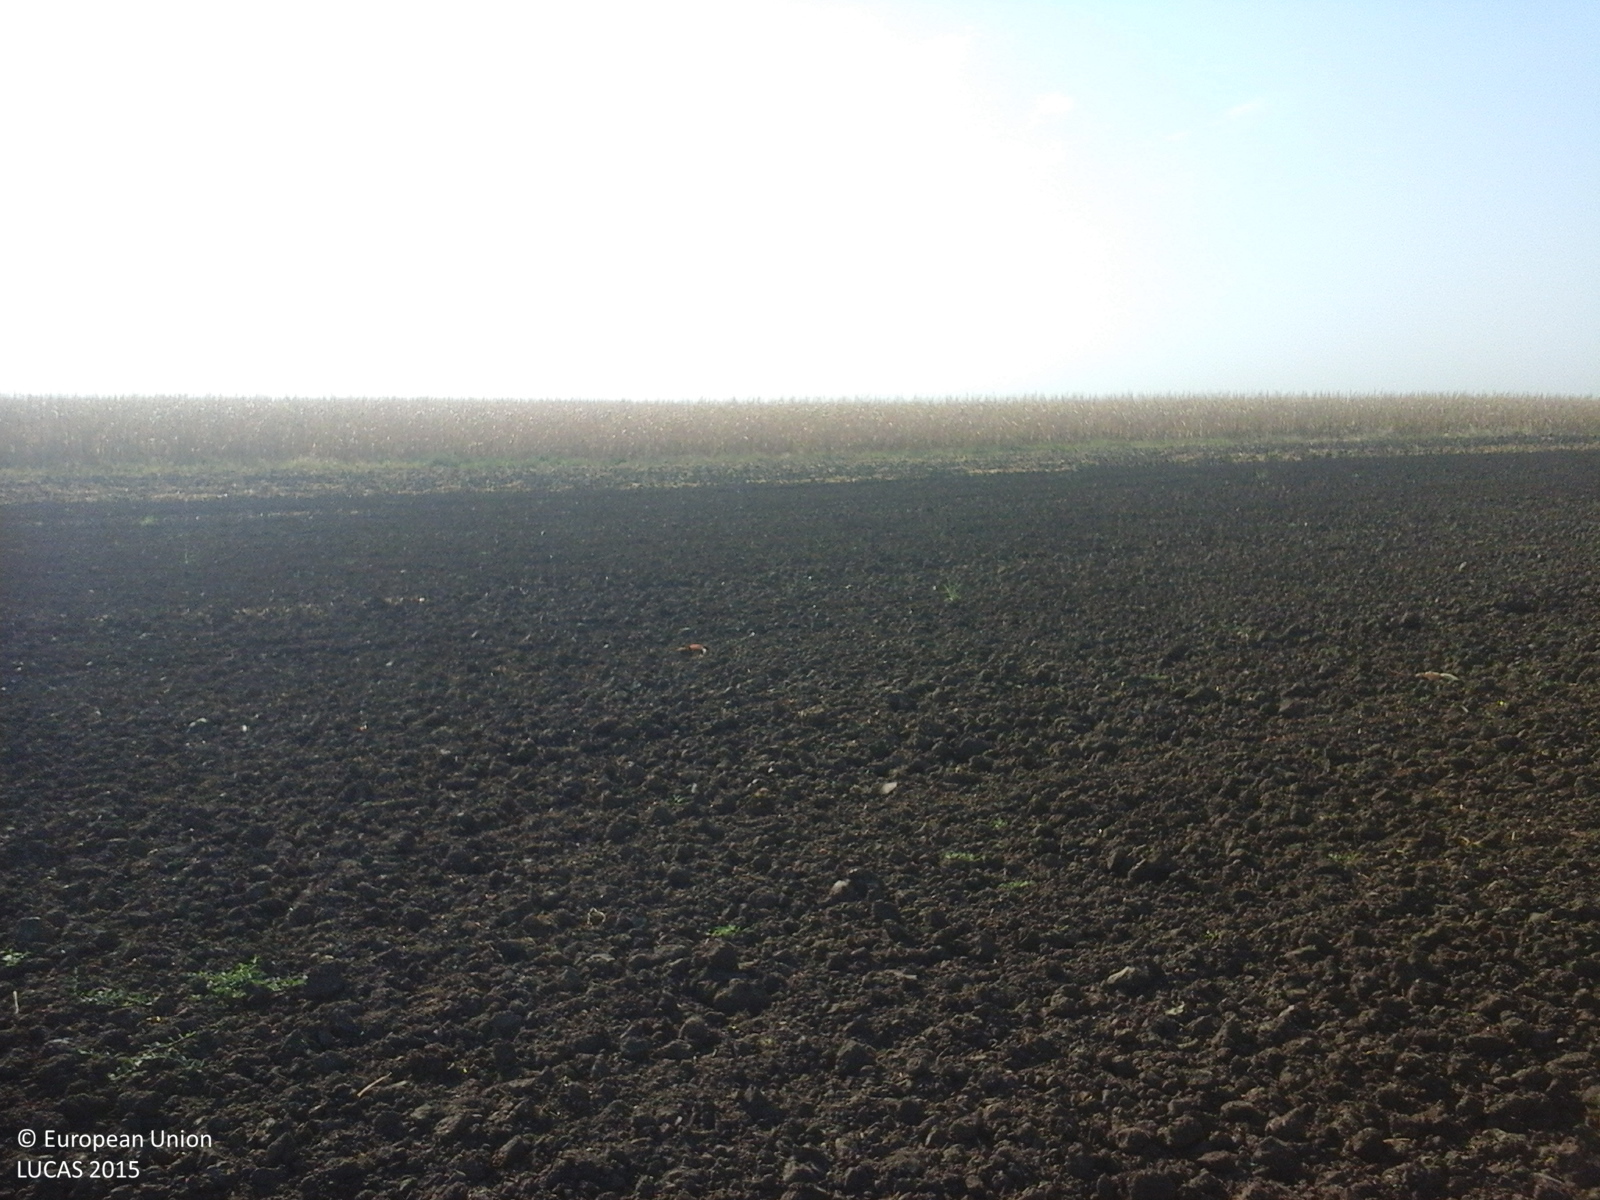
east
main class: Cropland
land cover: Barley
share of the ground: < 10 %
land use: Agriculture (excluding fallow land and kitchen gardens)
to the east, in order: Barley; Grass margins; Ditches and canals; Grass margins; Maize; Grass margins; Tracks; Grass margins; Maize
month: August
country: RO
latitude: 44.2016
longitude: 23.0197
